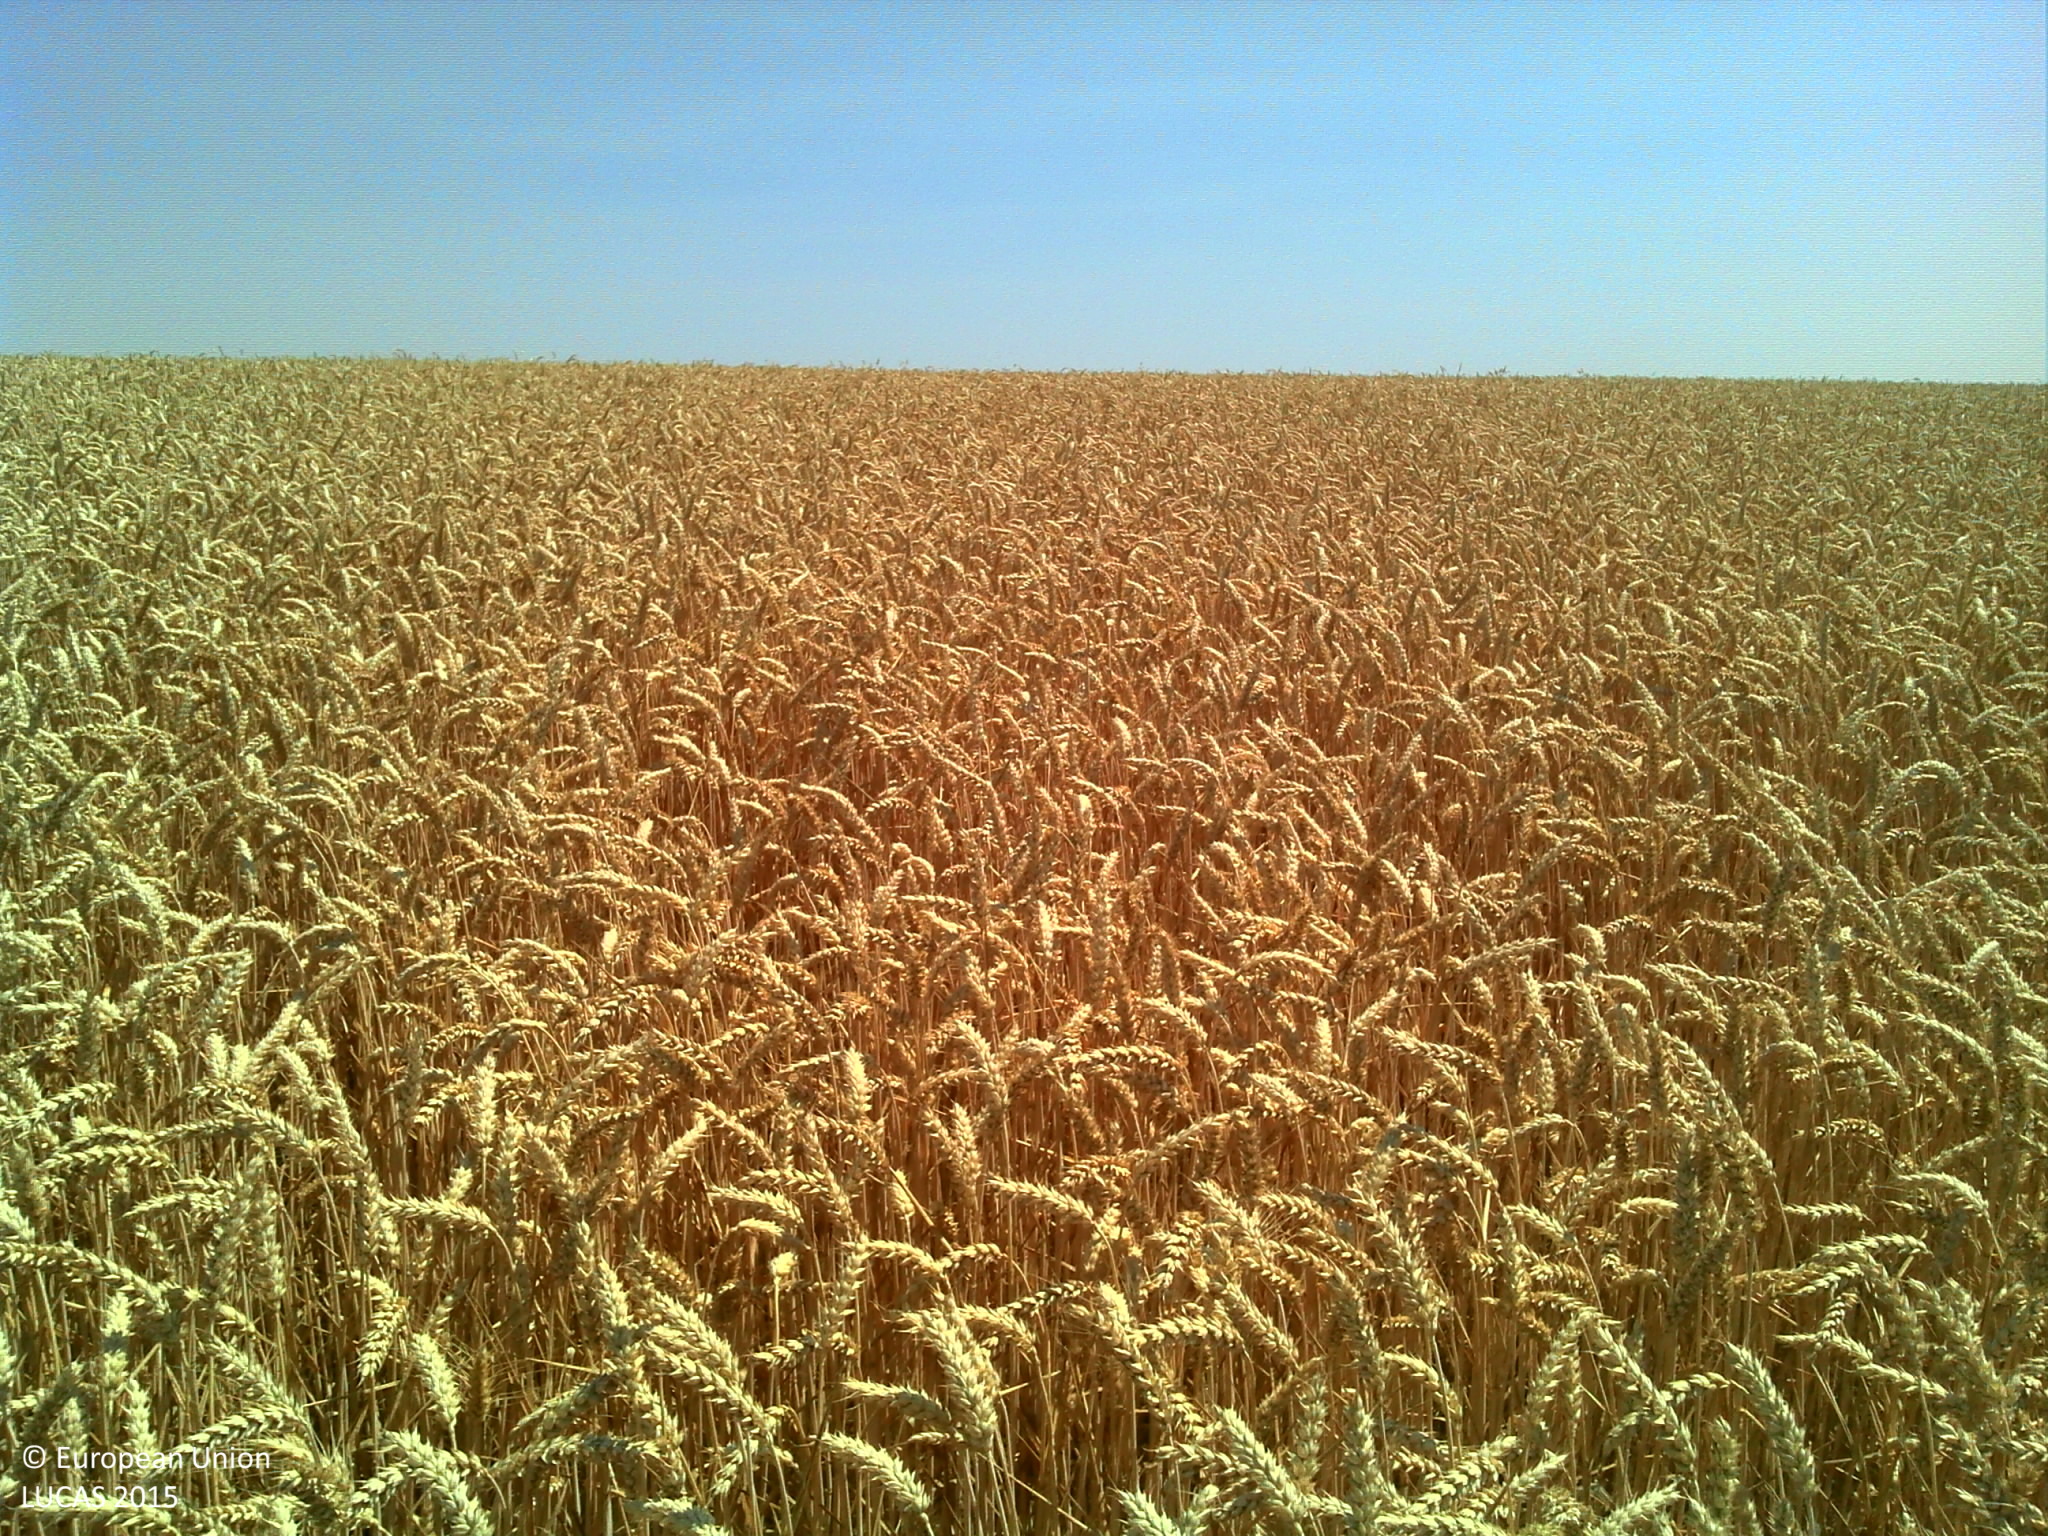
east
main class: Cropland
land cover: Common wheat
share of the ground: > 75 %
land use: Agriculture (excluding fallow land and kitchen gardens)
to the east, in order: Common wheat
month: July
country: FR
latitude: 47.0259
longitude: 3.5900
